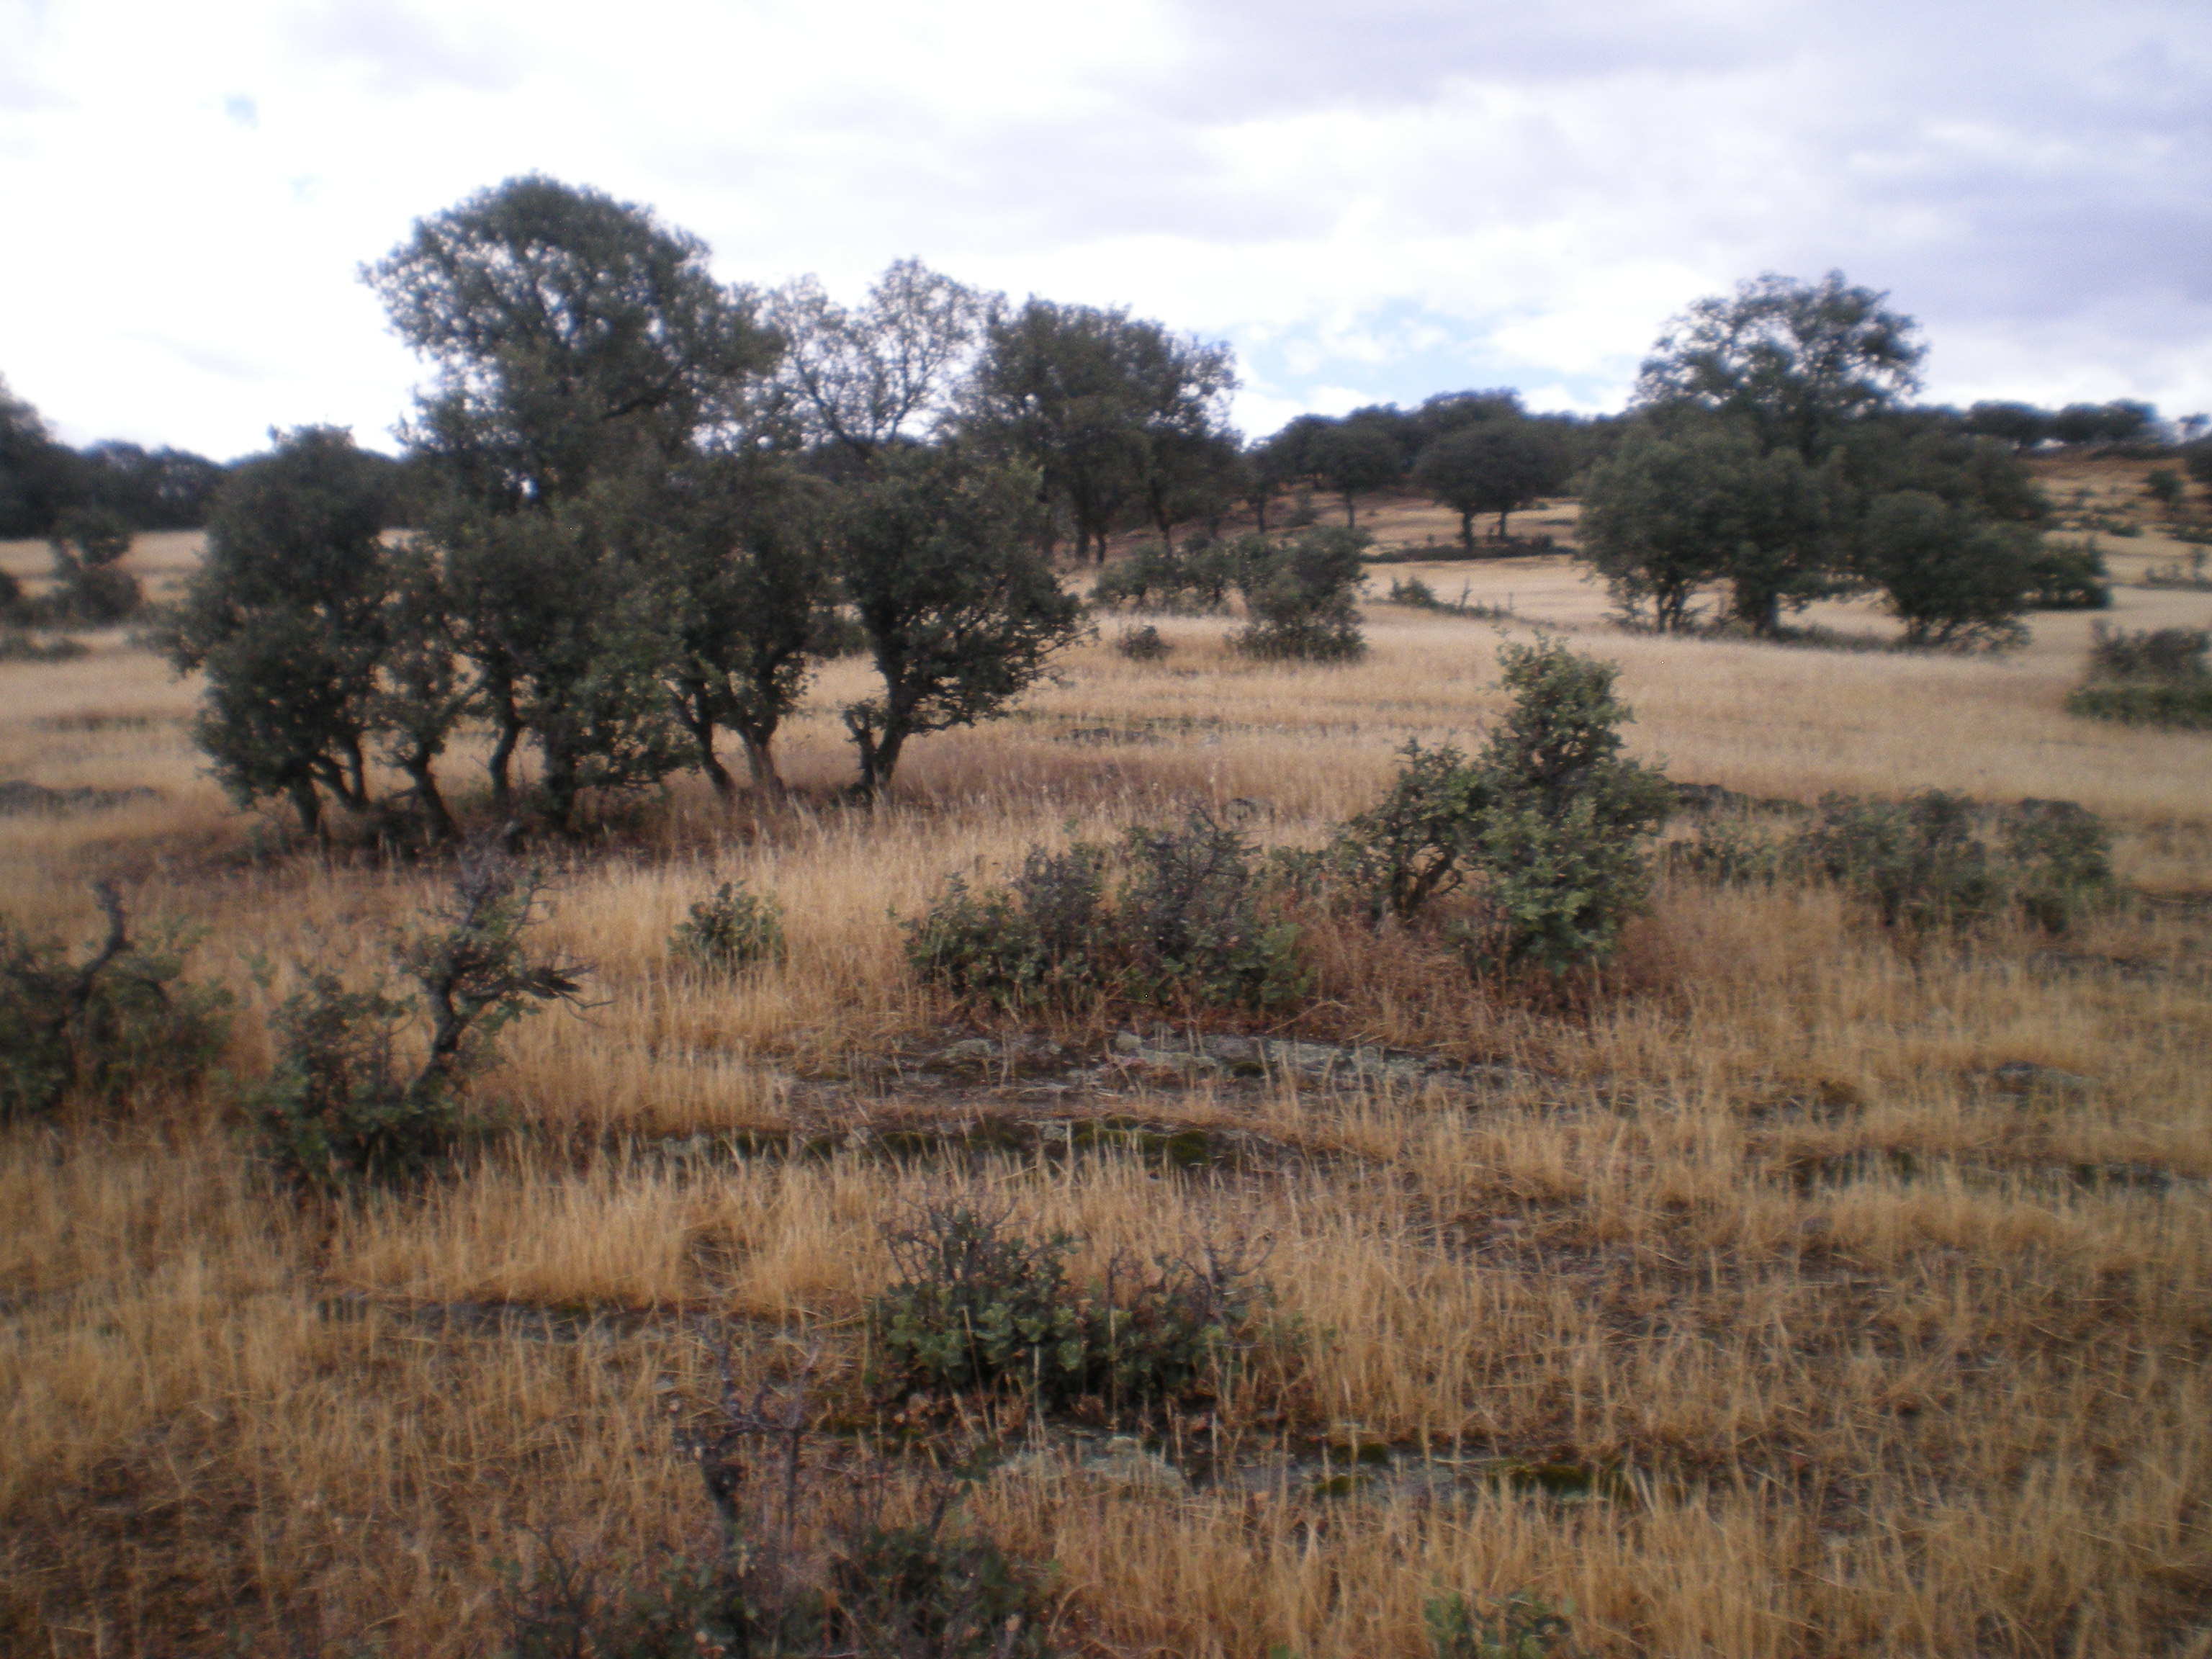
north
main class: Grassland
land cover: Grassland with sparse tree/shrub cover
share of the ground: 10 - 25 %
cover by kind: unconsolidated bare surface 80 %, herbaceous plants 15 %, broadleaved forest trees 5 %
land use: Agriculture (excluding fallow land and kitchen gardens)
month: June
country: ES
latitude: 38.4519
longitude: -3.3557
